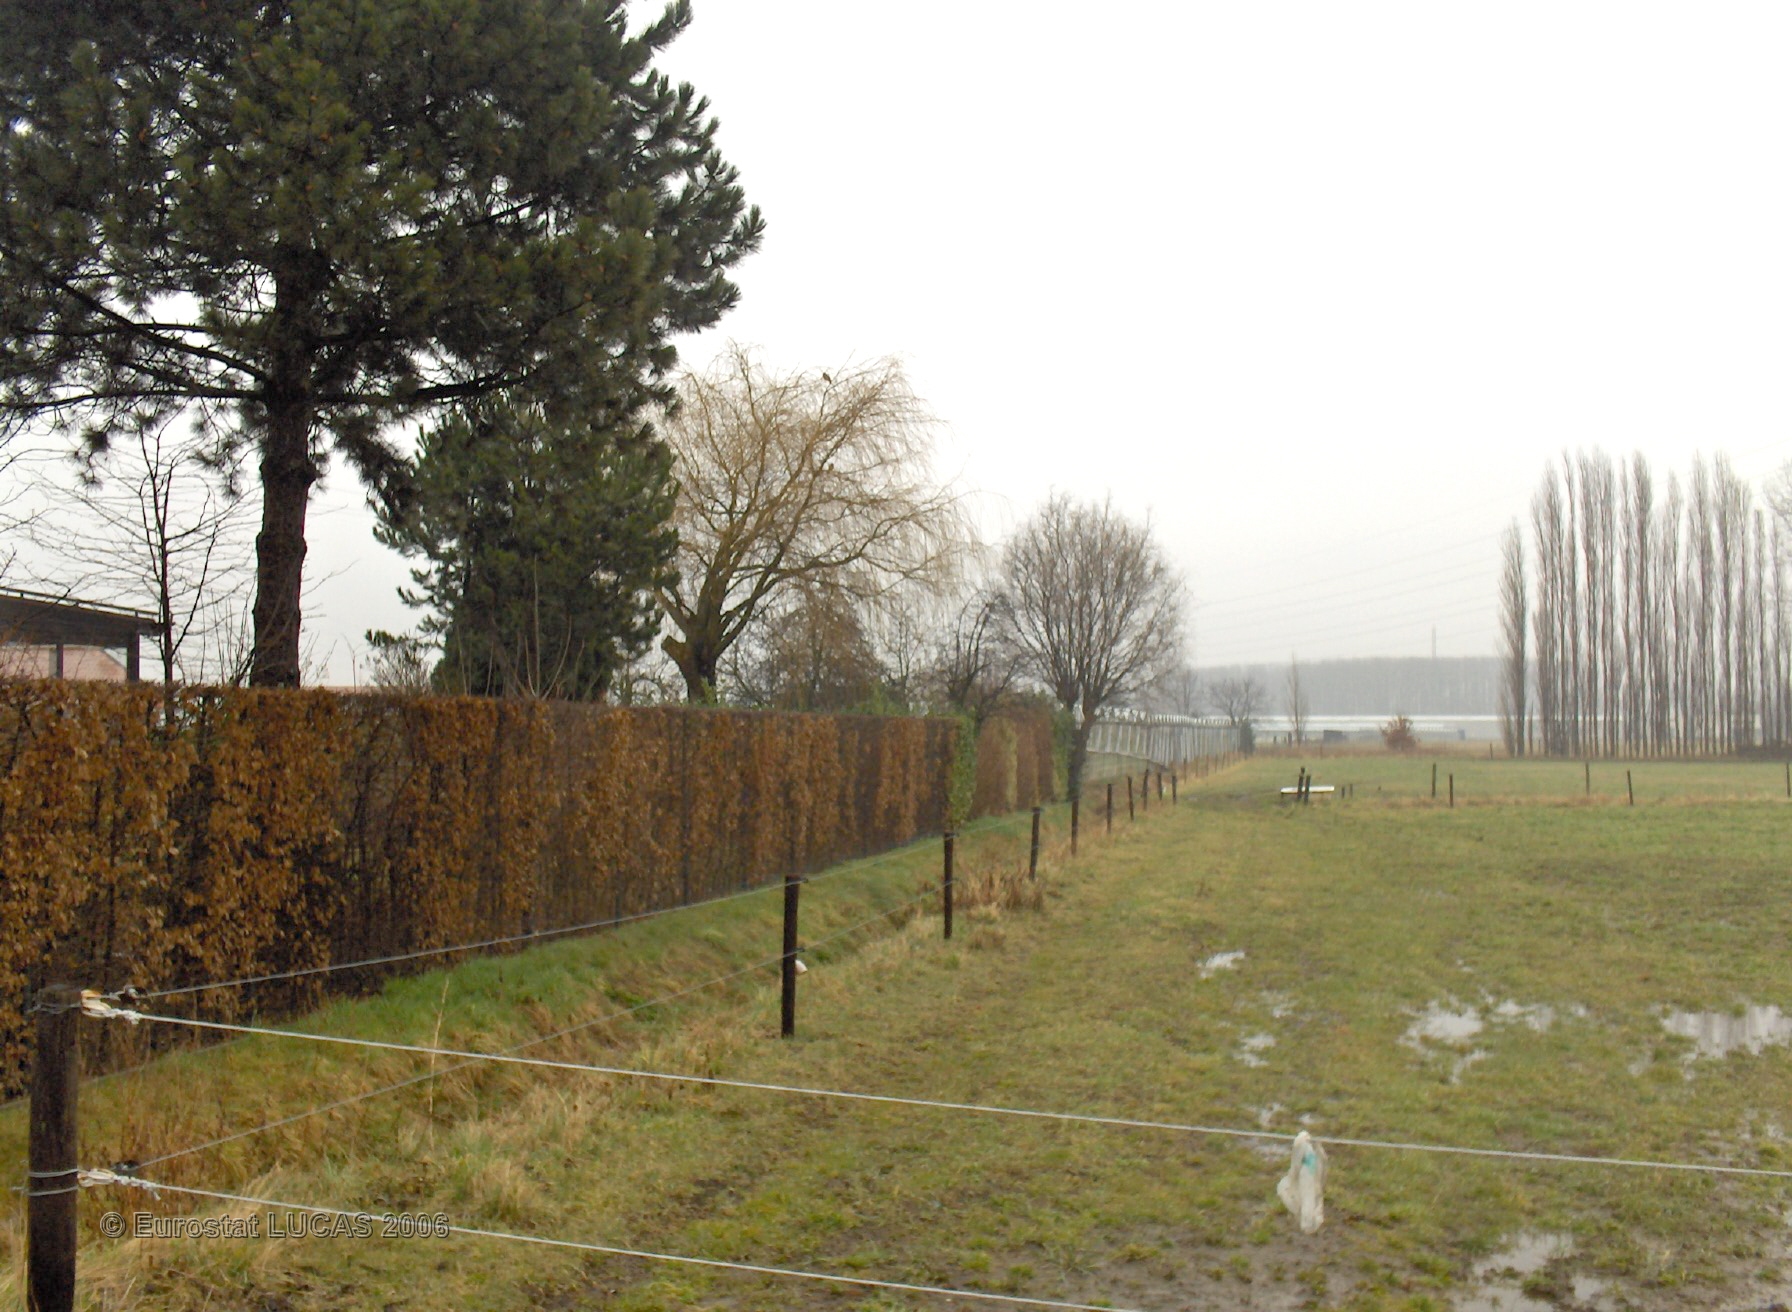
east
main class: Grassland
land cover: Grassland without tree/shrub cover
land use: Agriculture (excluding fallow land and kitchen gardens)
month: March
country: BE
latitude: 51.1147
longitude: 4.4960
